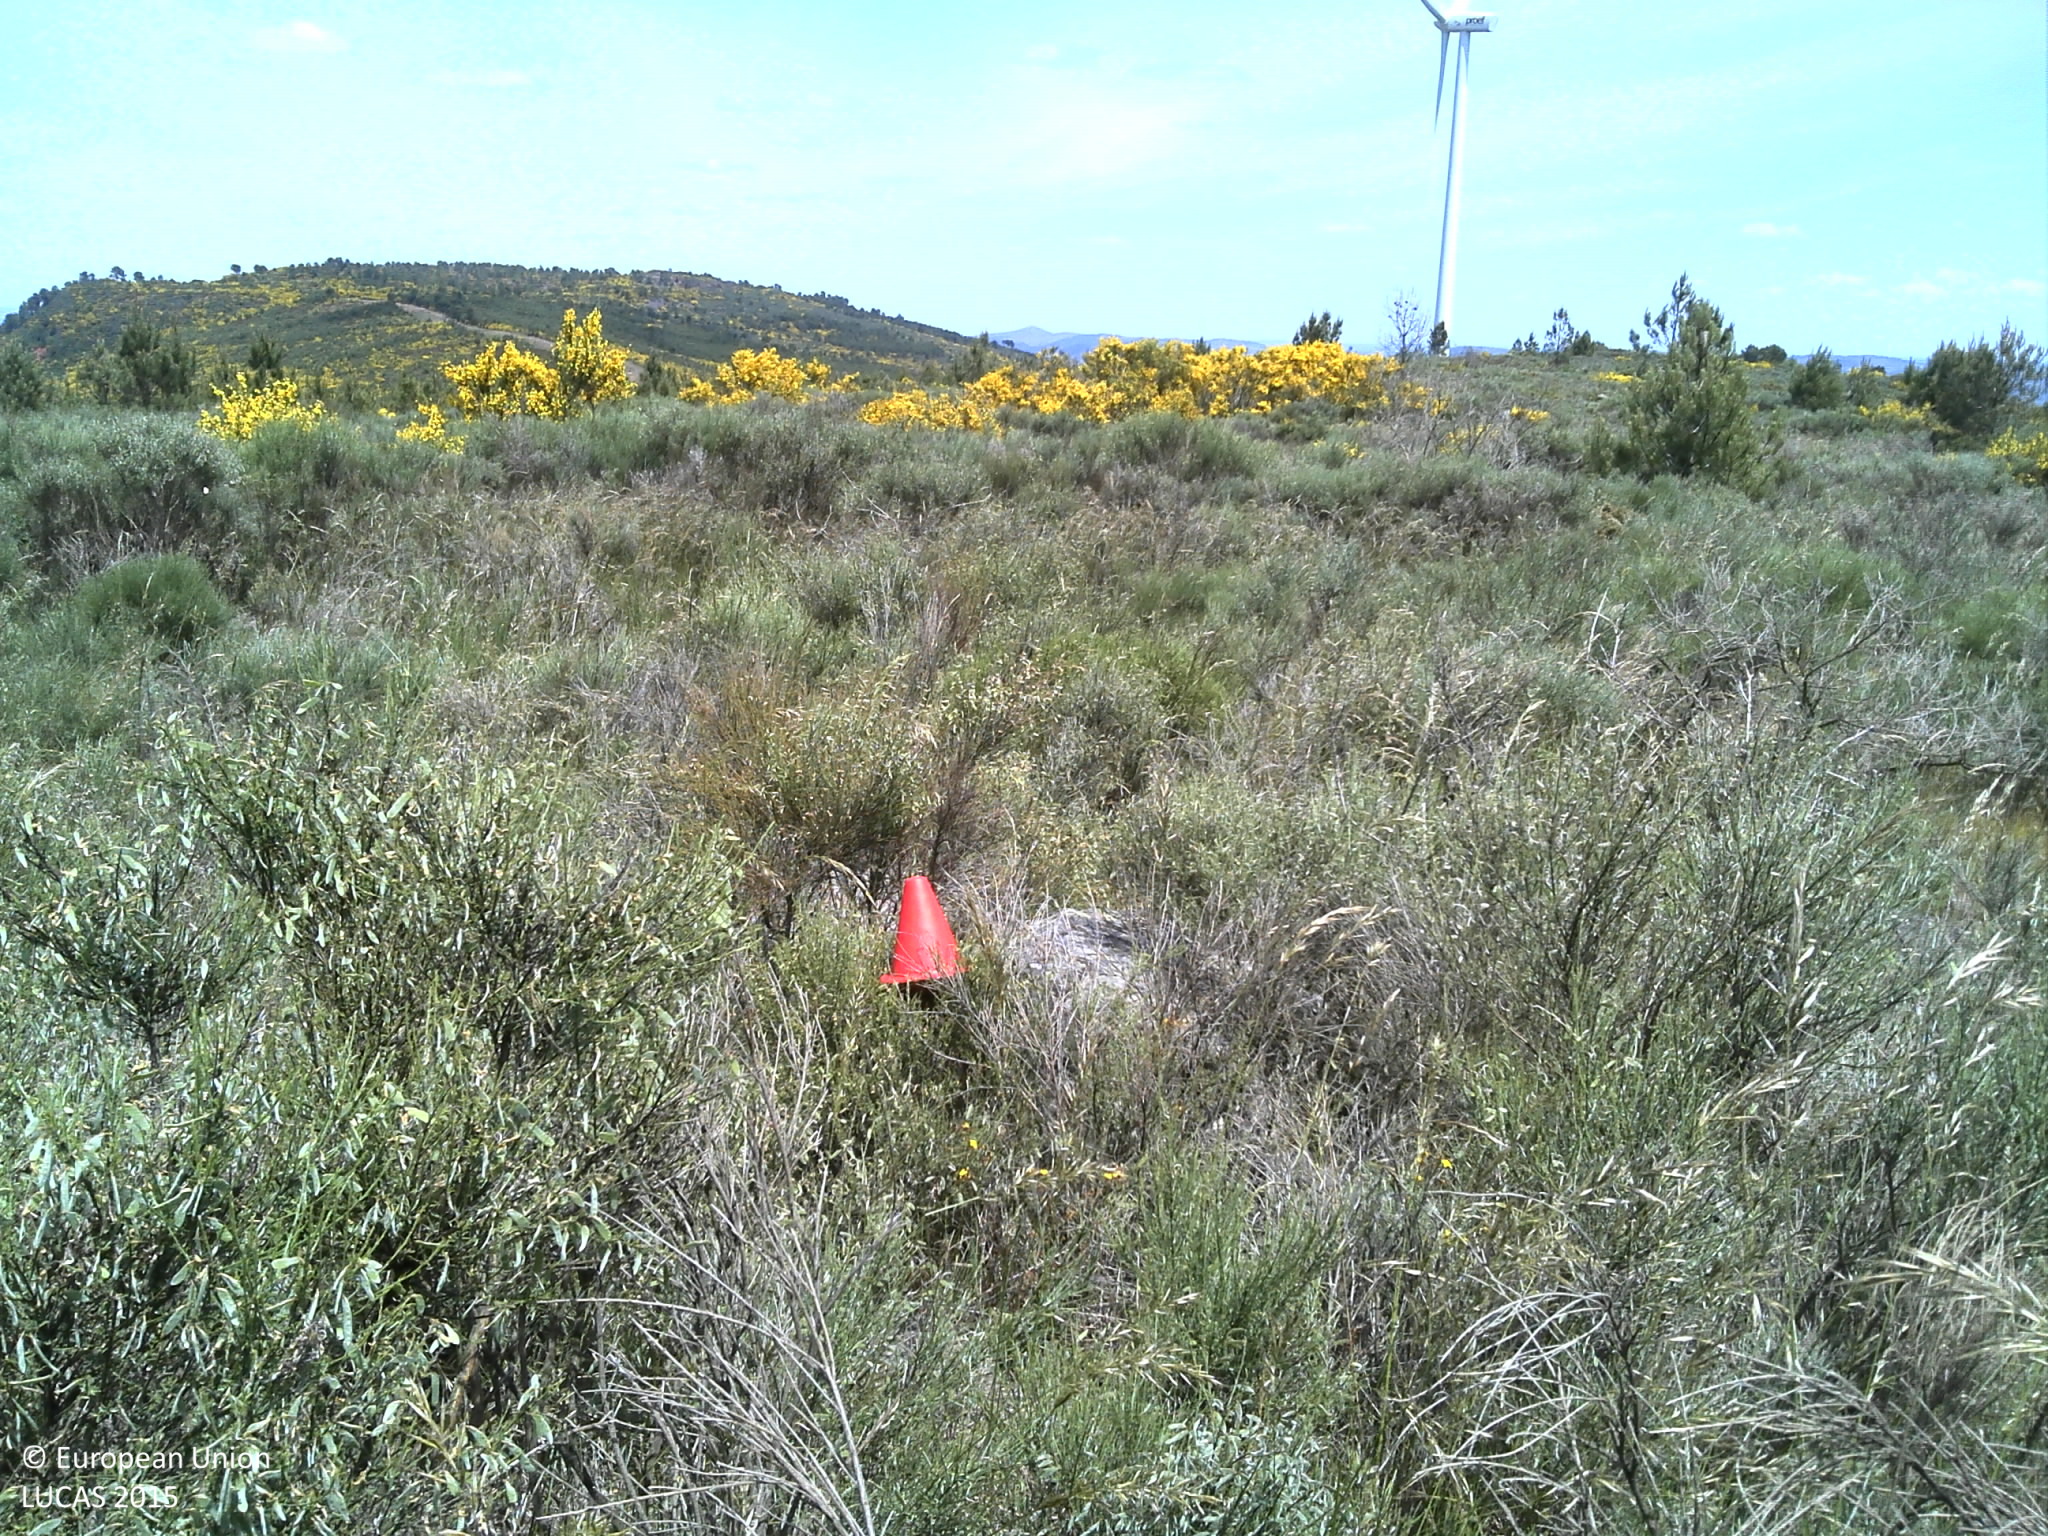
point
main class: Shrubland
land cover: Shrubland with sparse tree cover
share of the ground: > 75 %
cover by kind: shrubs 90 %, coniferous forest trees 5 %, consolidated bare surface 5 %
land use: Forestry
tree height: < 5 m
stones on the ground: < 10 %
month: May
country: PT
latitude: 41.1720
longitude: -6.9751
